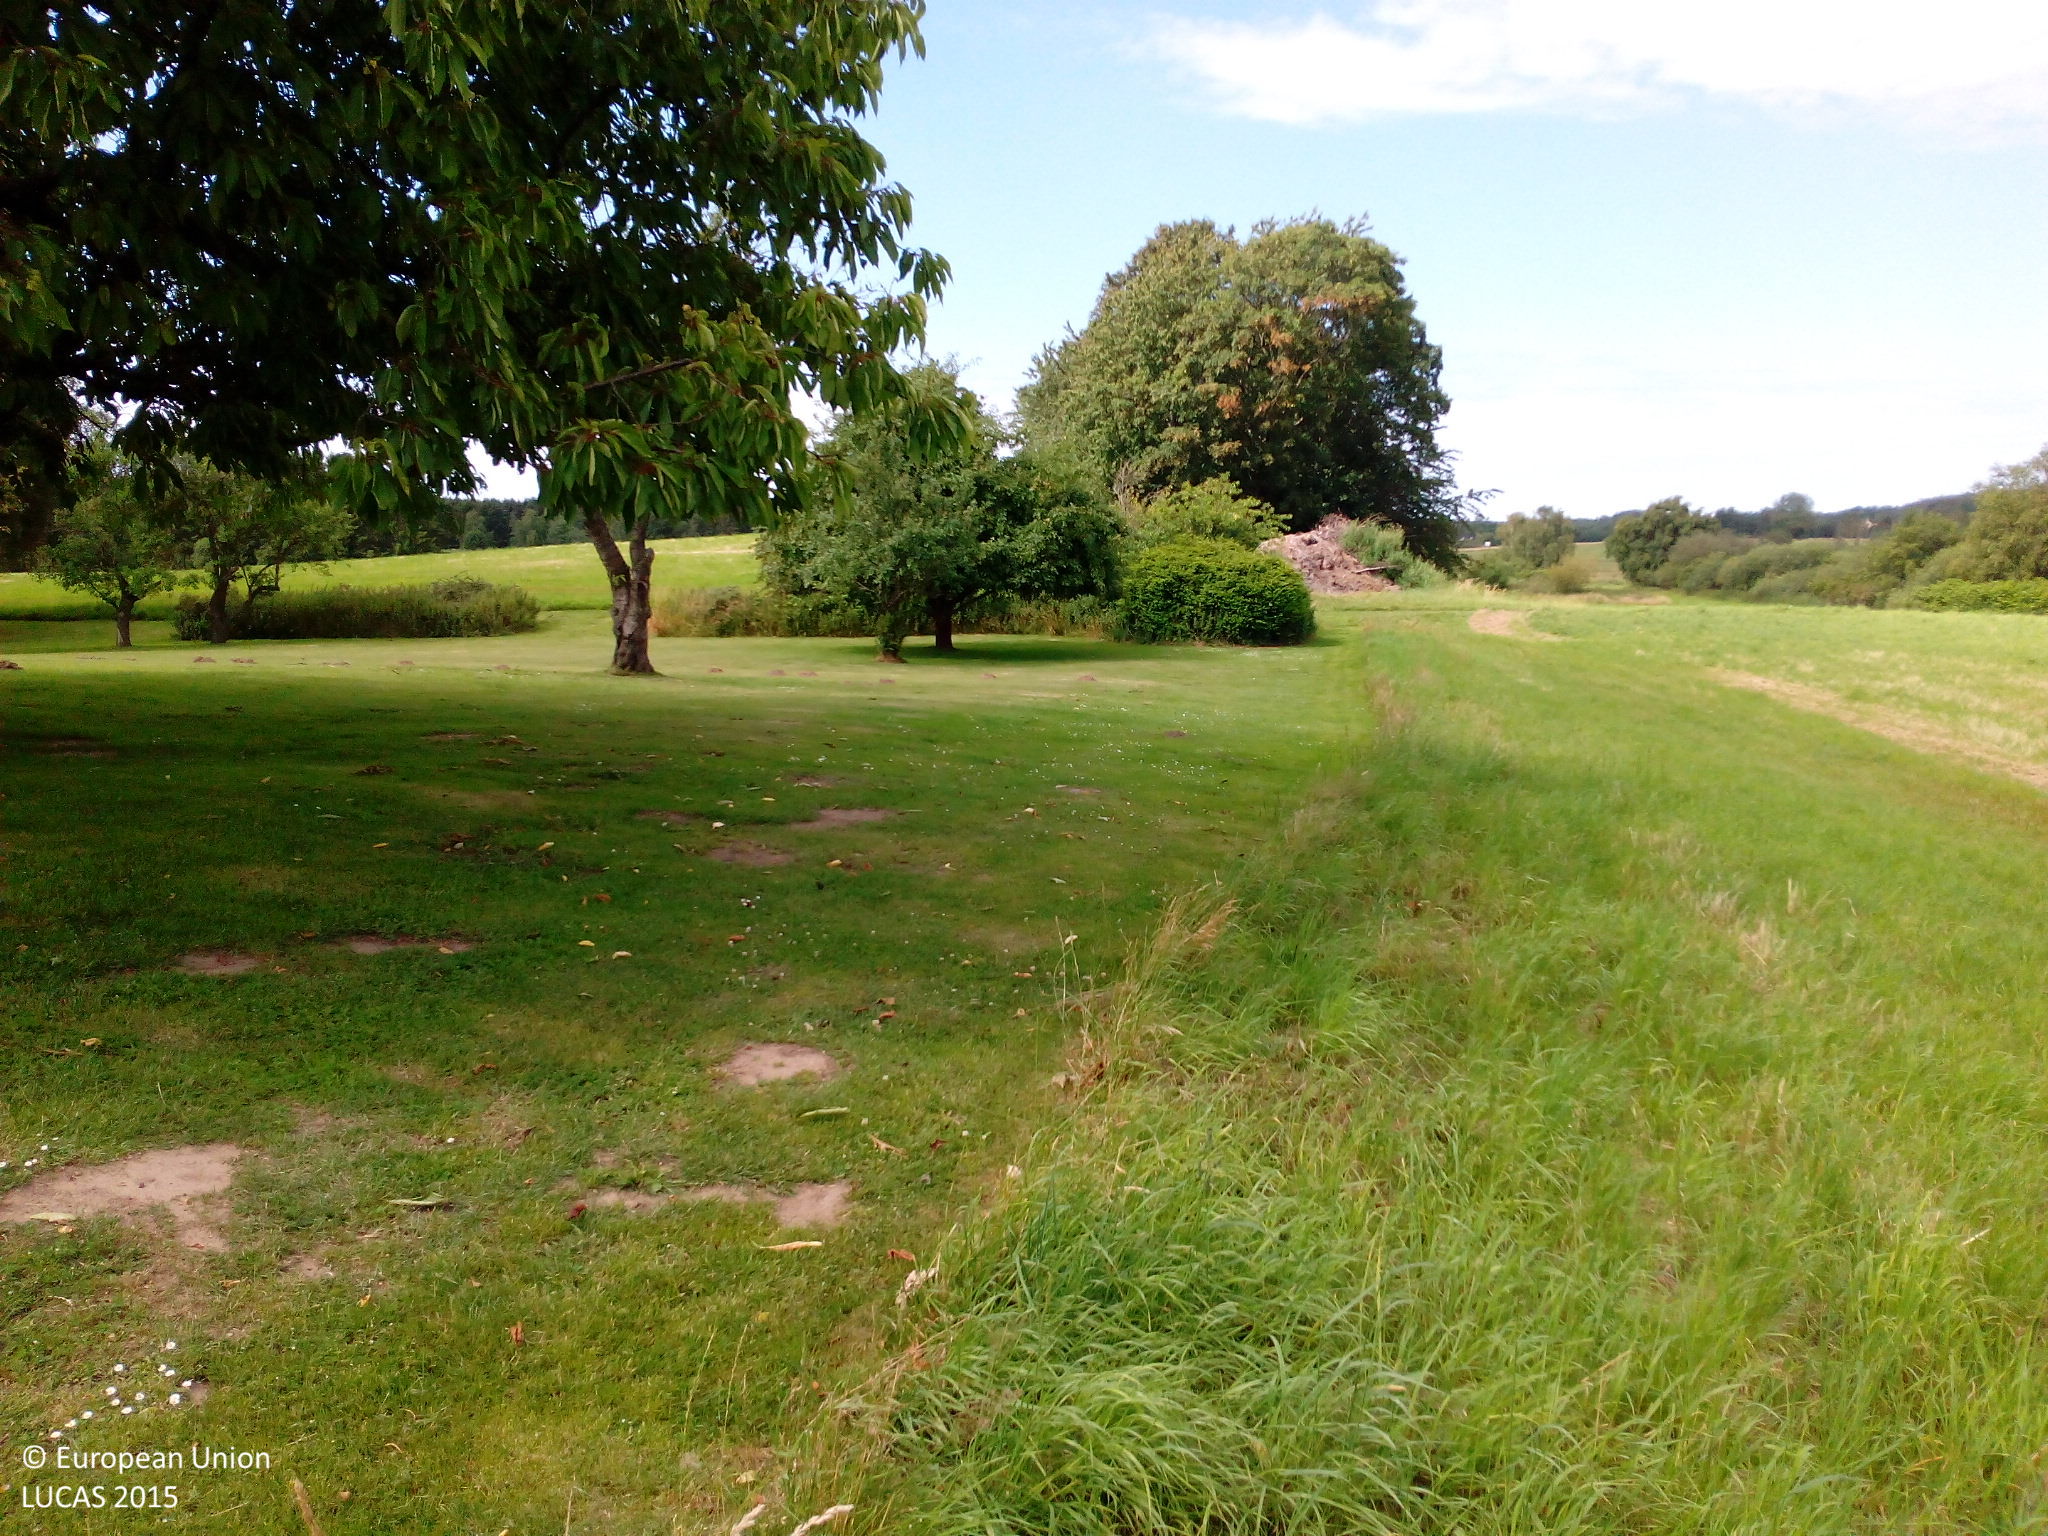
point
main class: Grassland
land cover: Grassland without tree/shrub cover
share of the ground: > 75 %
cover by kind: herbaceous plants 100 %
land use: Agriculture (excluding fallow land and kitchen gardens)
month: July
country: DK
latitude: 56.0582
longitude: 12.3584
